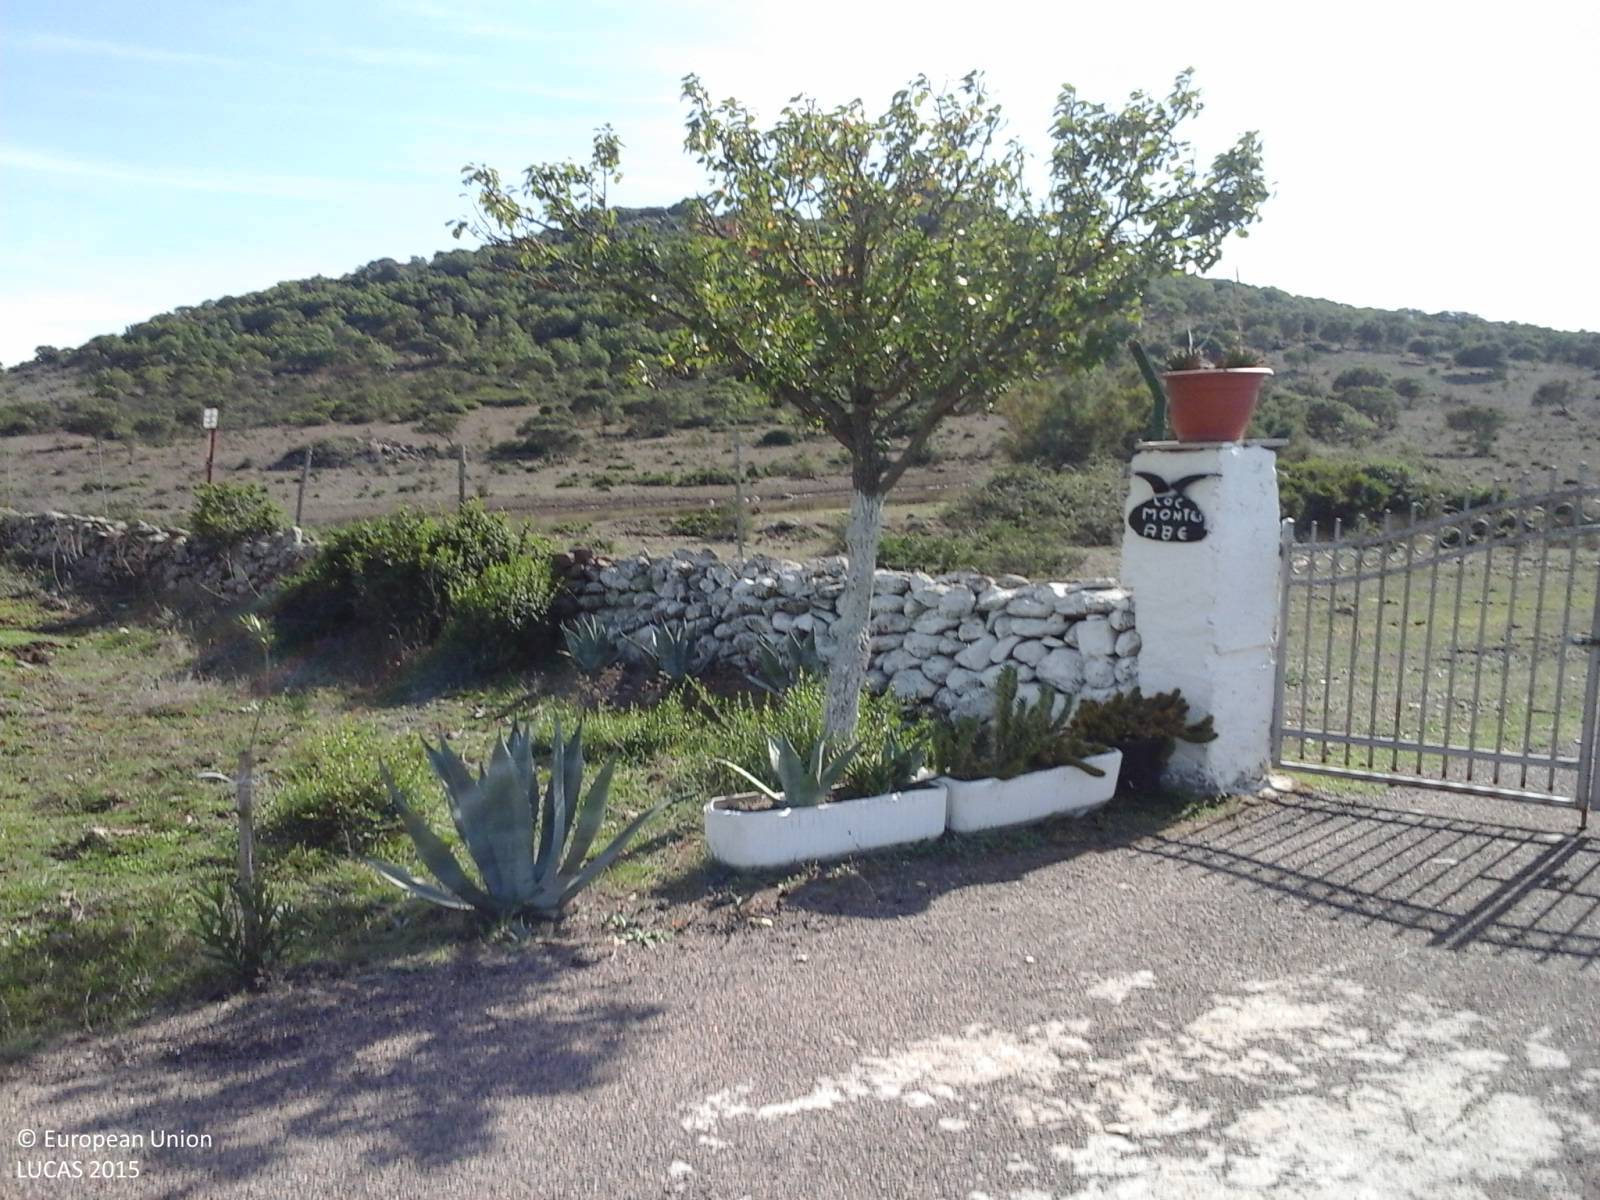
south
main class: Grassland
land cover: Grassland without tree/shrub cover
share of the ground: > 75 %
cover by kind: herbaceous plants 100 %
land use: Agriculture (excluding fallow land and kitchen gardens)
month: October
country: IT
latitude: 40.4193
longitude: 8.5342
